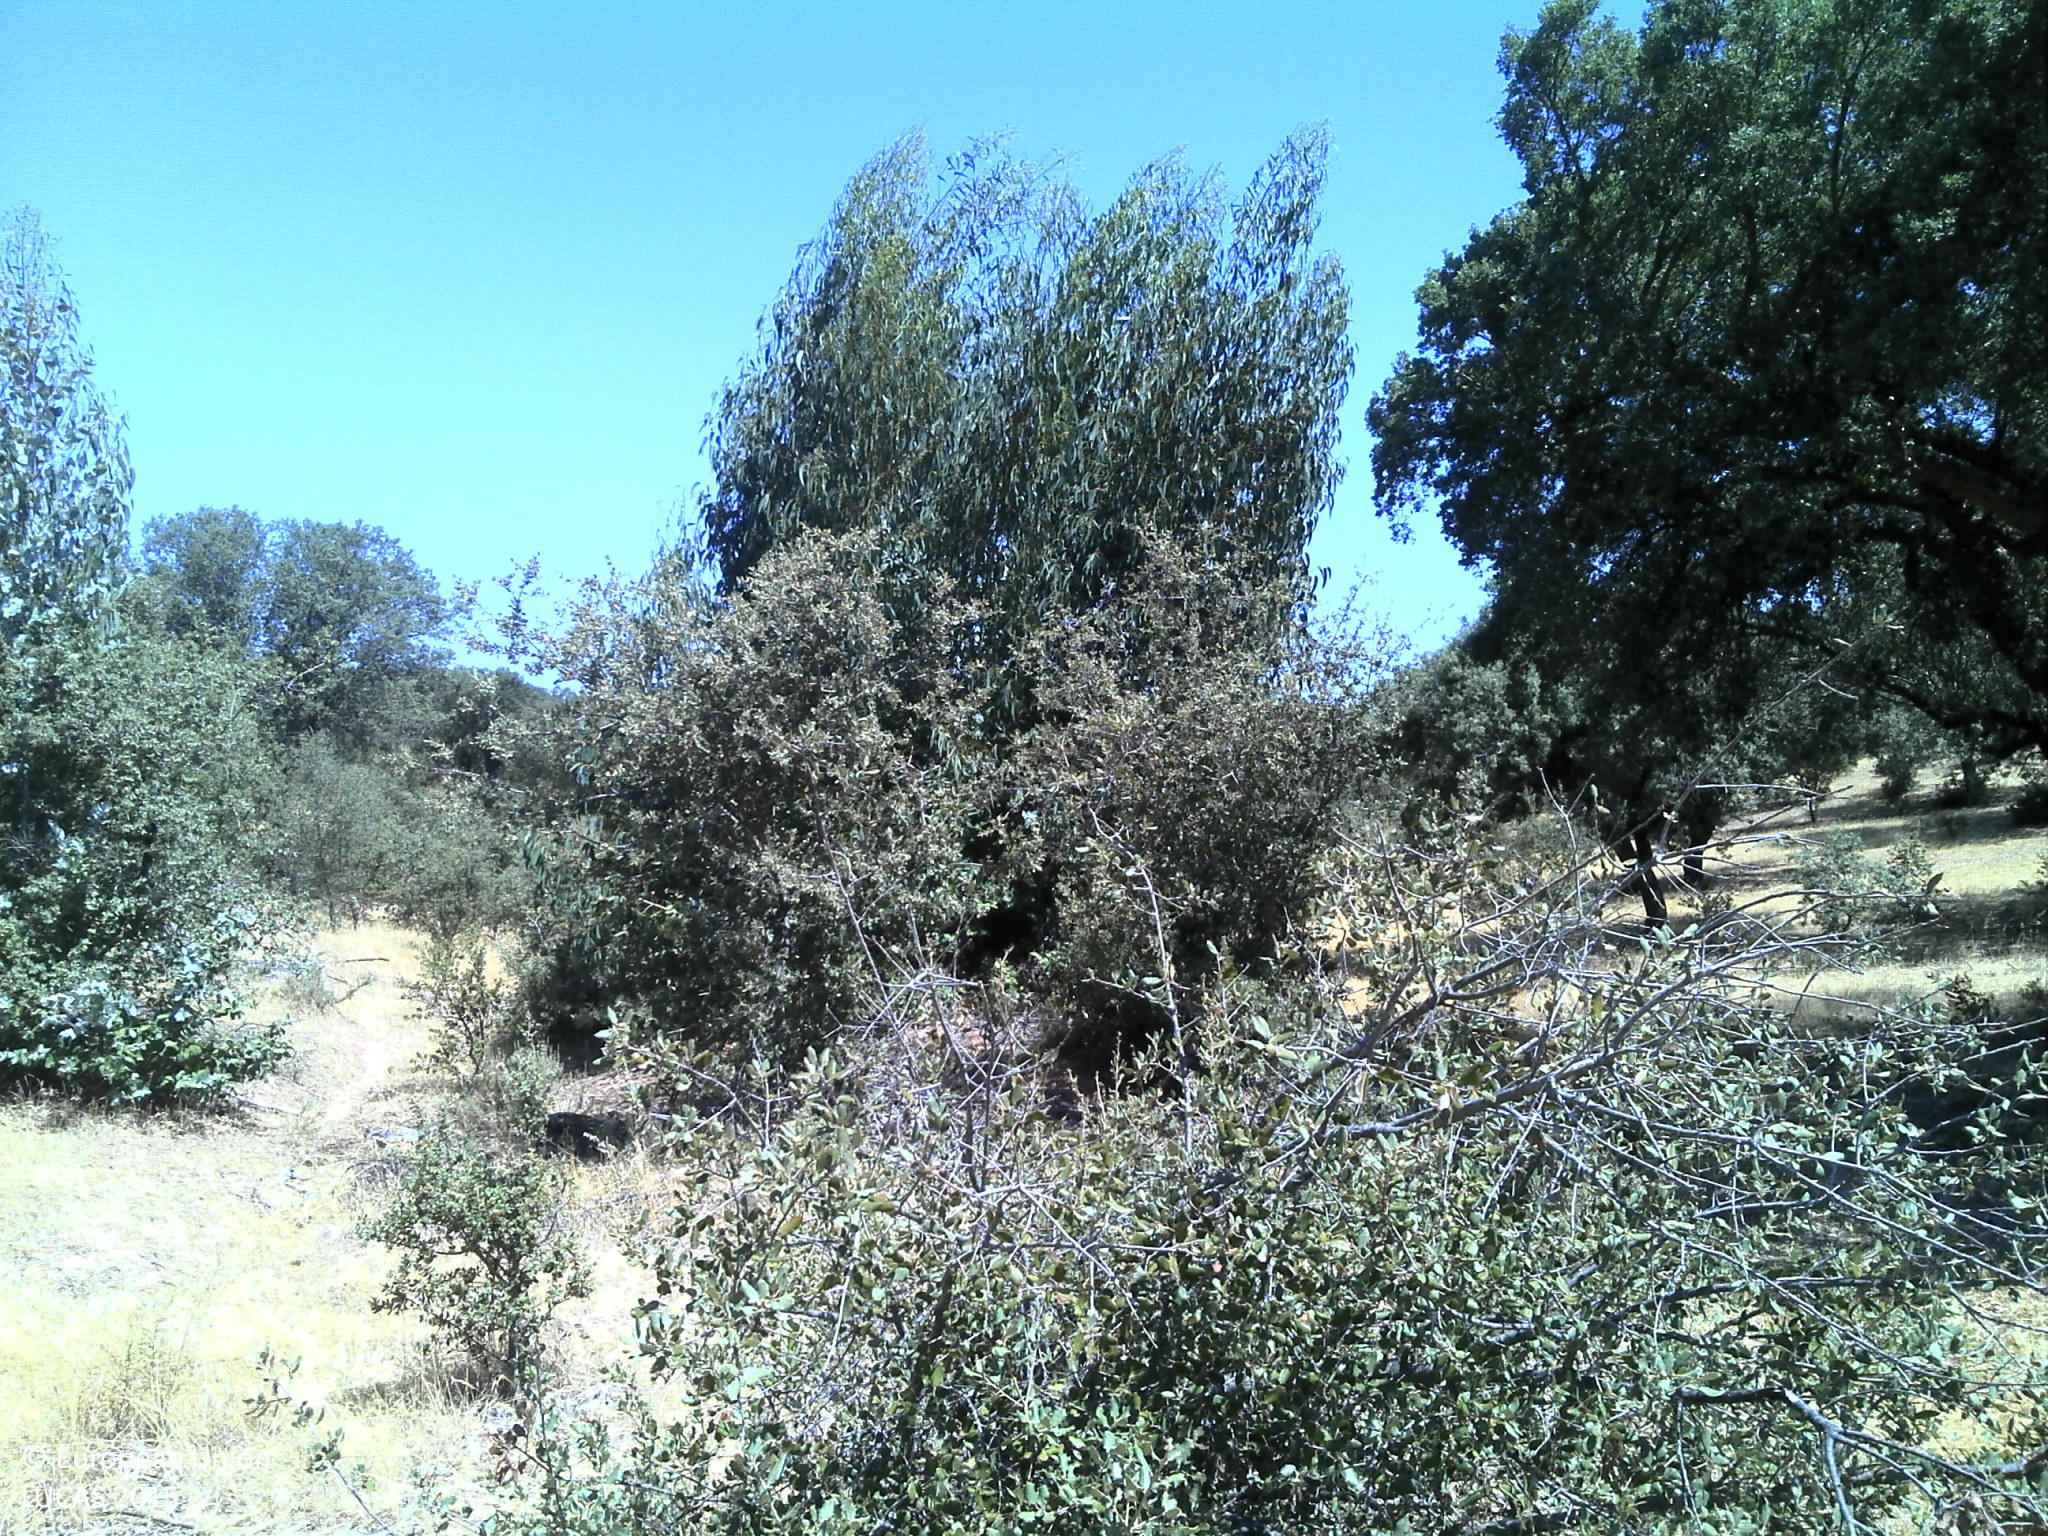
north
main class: Woodland
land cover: Broadleaved woodland
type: broadleaved evergreen forest
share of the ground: 25 - 50 %
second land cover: Grassland without tree/shrub cover
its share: 25 - 50 %
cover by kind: broadleaved forest trees 50 %, herbaceous plants 25 %, unconsolidated bare surface 25 %
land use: Forestry
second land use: Agriculture (excluding fallow land and kitchen gardens)
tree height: > 5 m
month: July
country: PT
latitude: 38.4799
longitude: -7.4863
